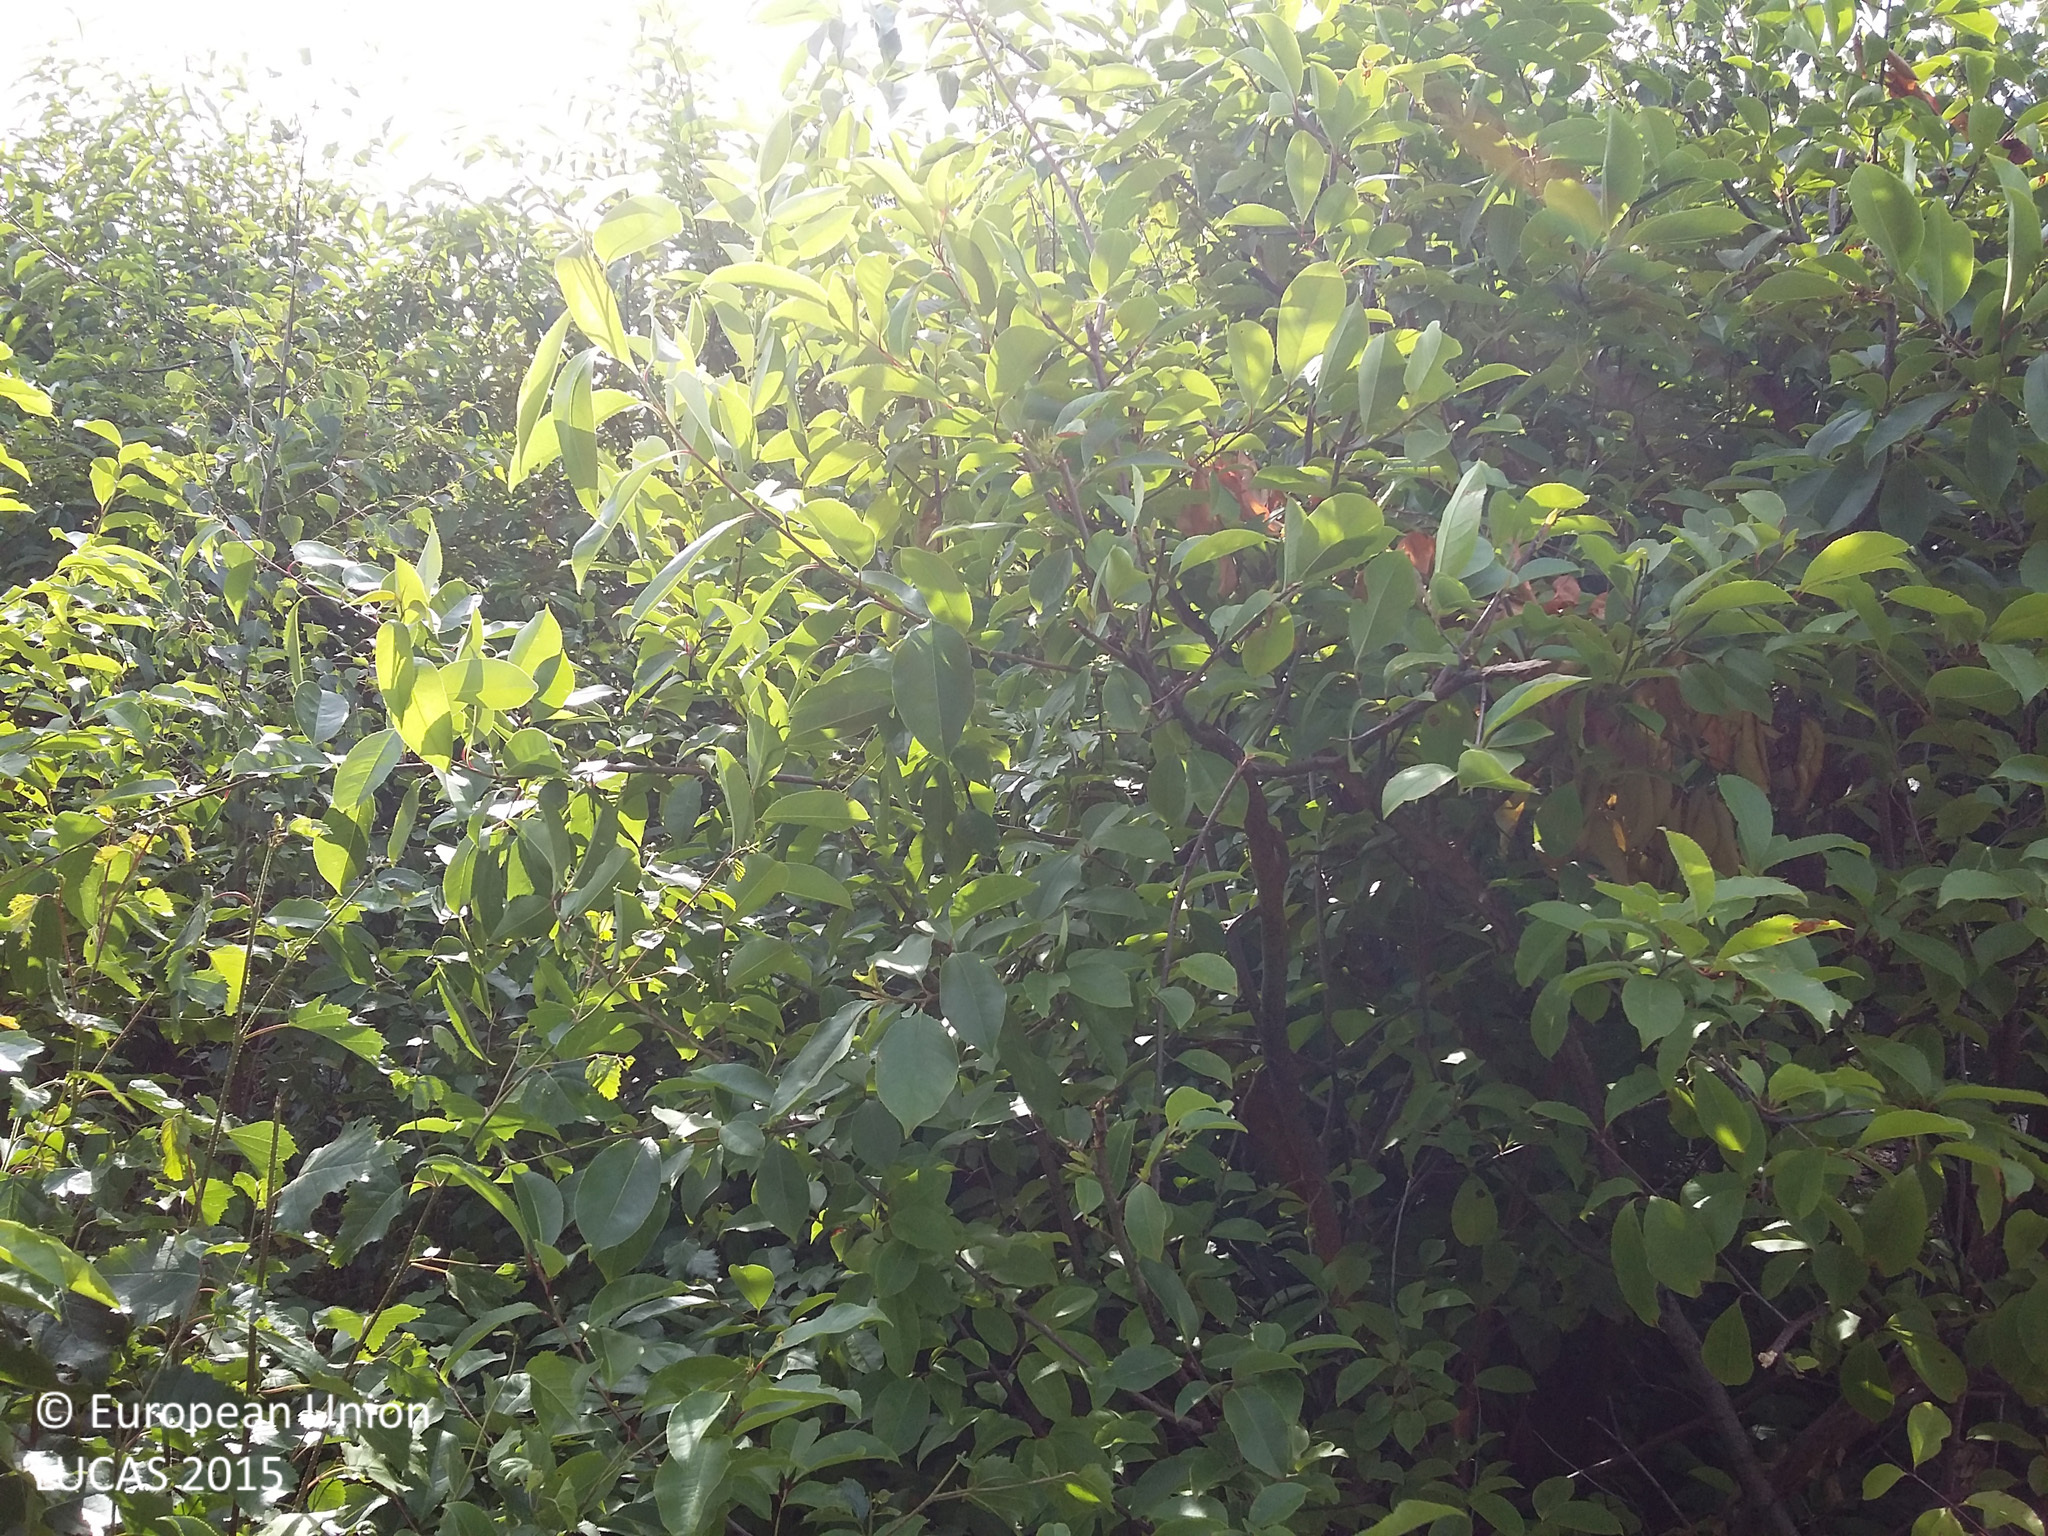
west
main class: Woodland
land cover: Broadleaved woodland
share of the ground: > 75 %
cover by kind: broadleaved forest trees 80 %, herbaceous plants 20 %
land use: Residential
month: July
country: DK
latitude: 56.0975
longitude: 12.1680
